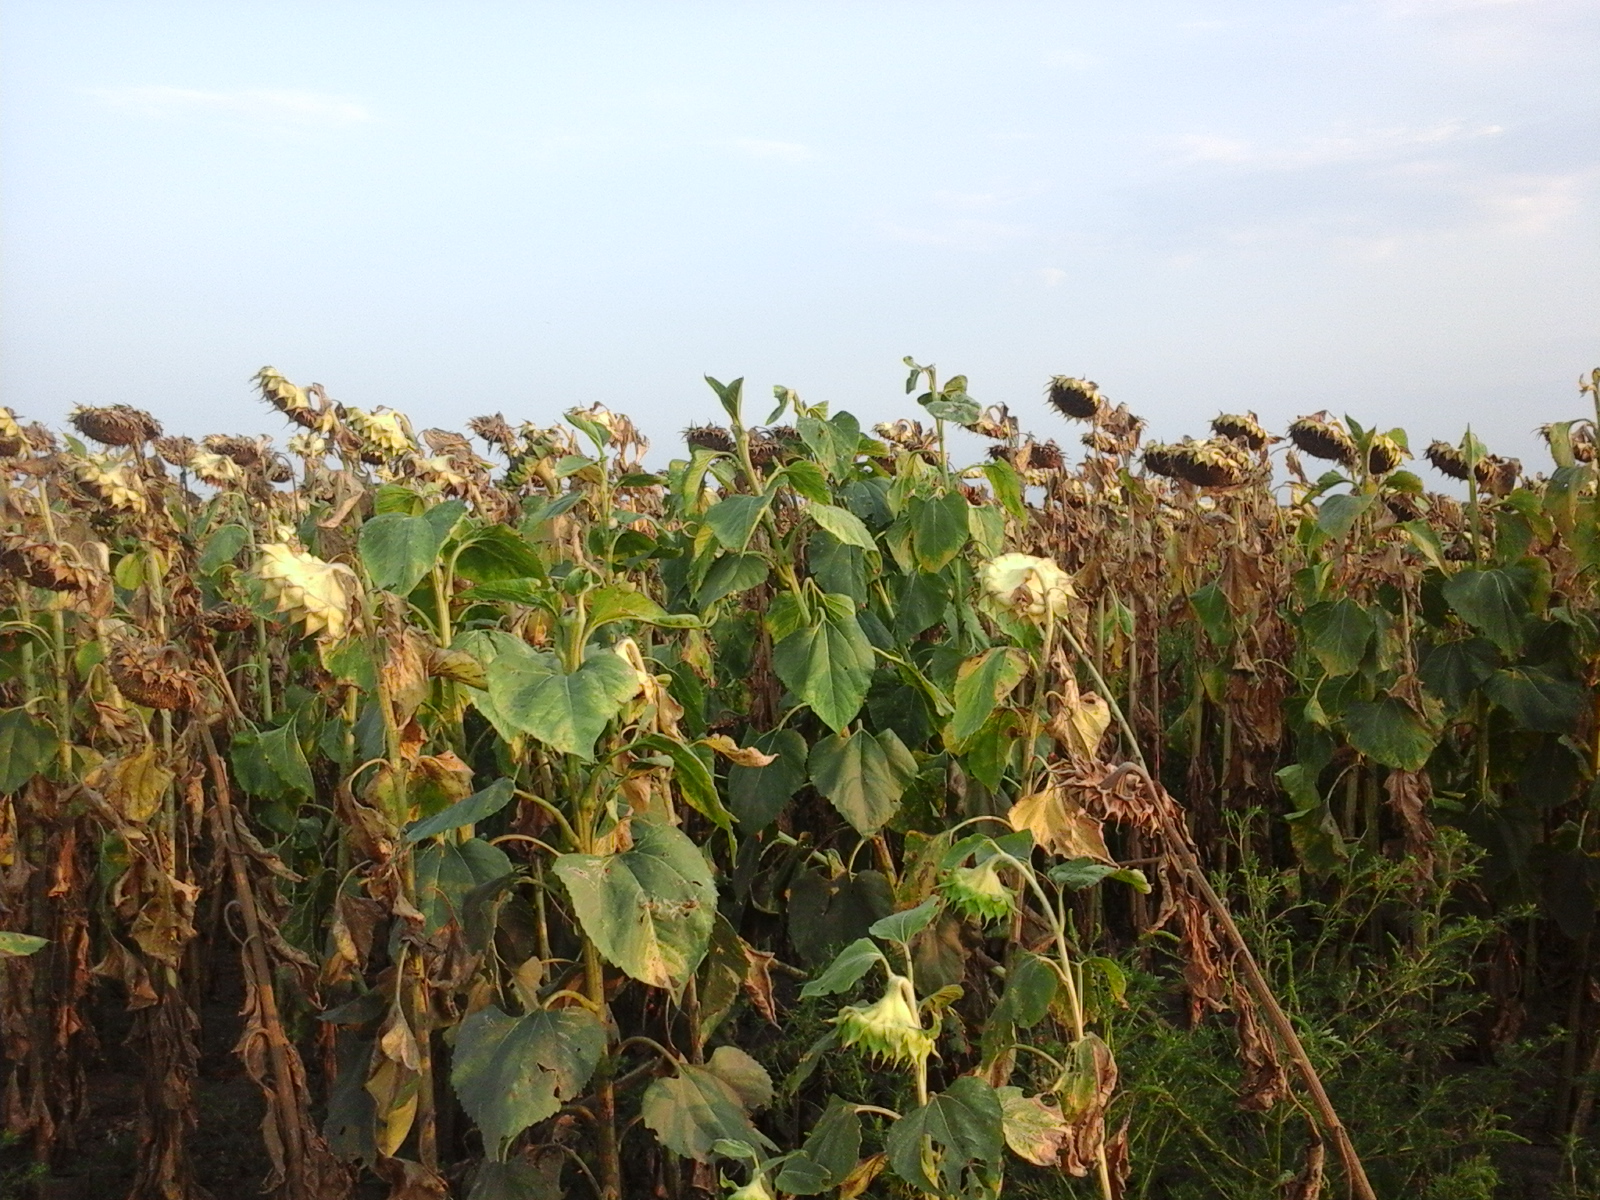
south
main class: Cropland
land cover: Sunflower
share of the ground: > 75 %
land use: Agriculture (excluding fallow land and kitchen gardens)
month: August
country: RO
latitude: 44.0428
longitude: 23.2619
